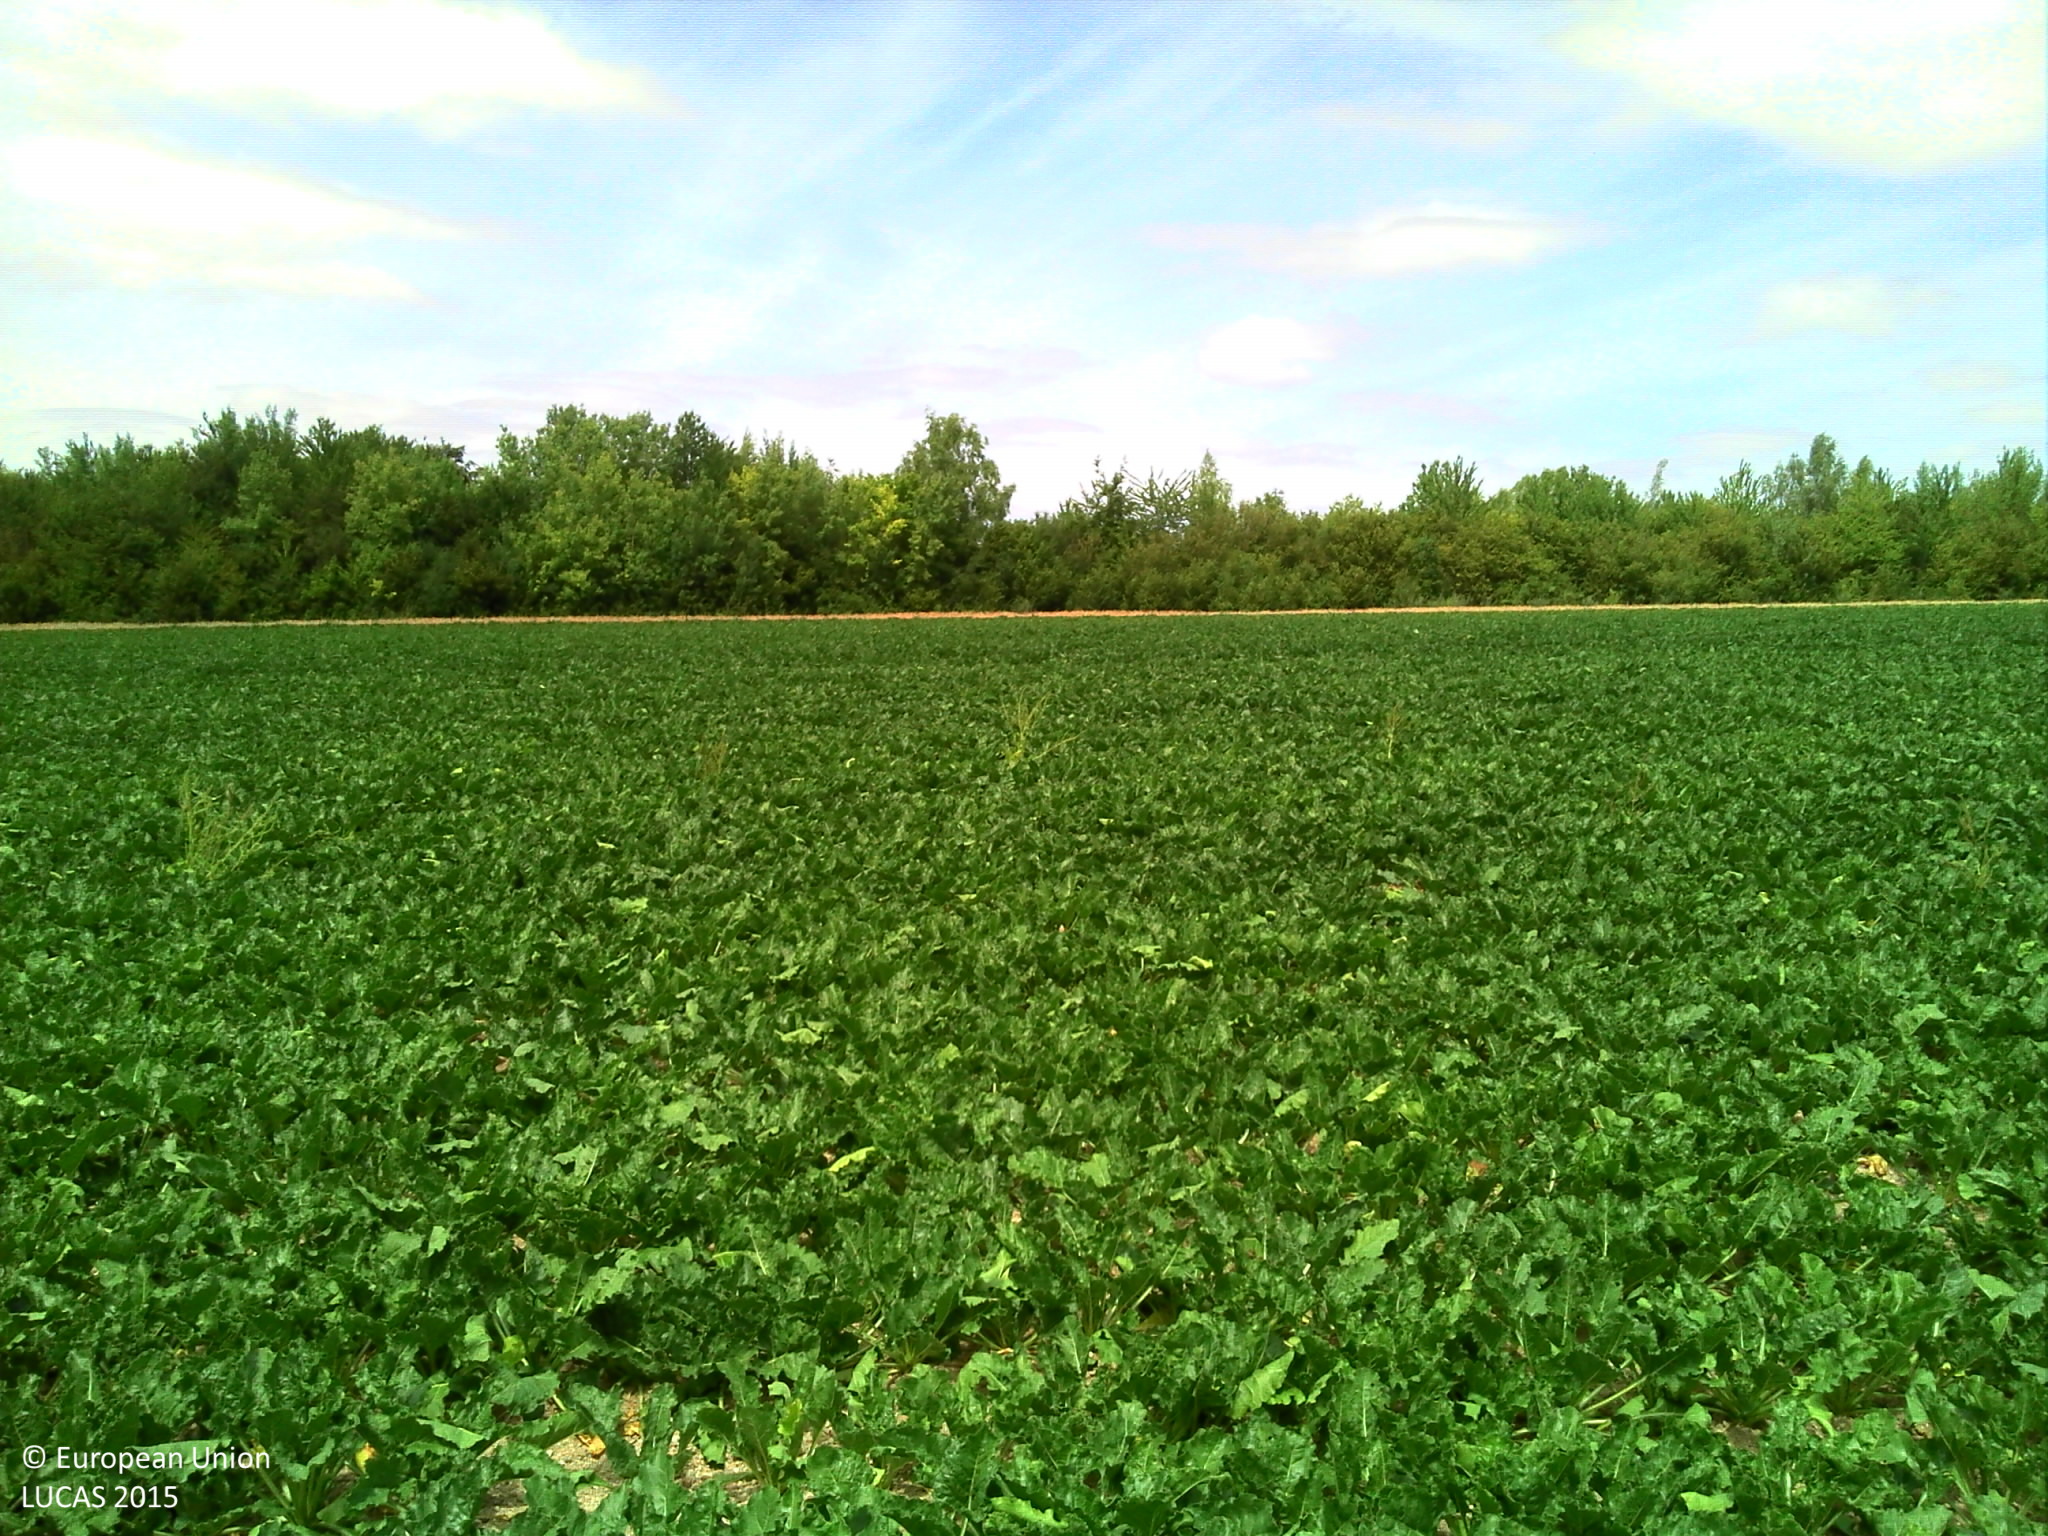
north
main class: Cropland
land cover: Sugar beet
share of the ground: > 75 %
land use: Agriculture (excluding fallow land and kitchen gardens)
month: July
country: FR
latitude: 49.4024
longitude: 4.1385
